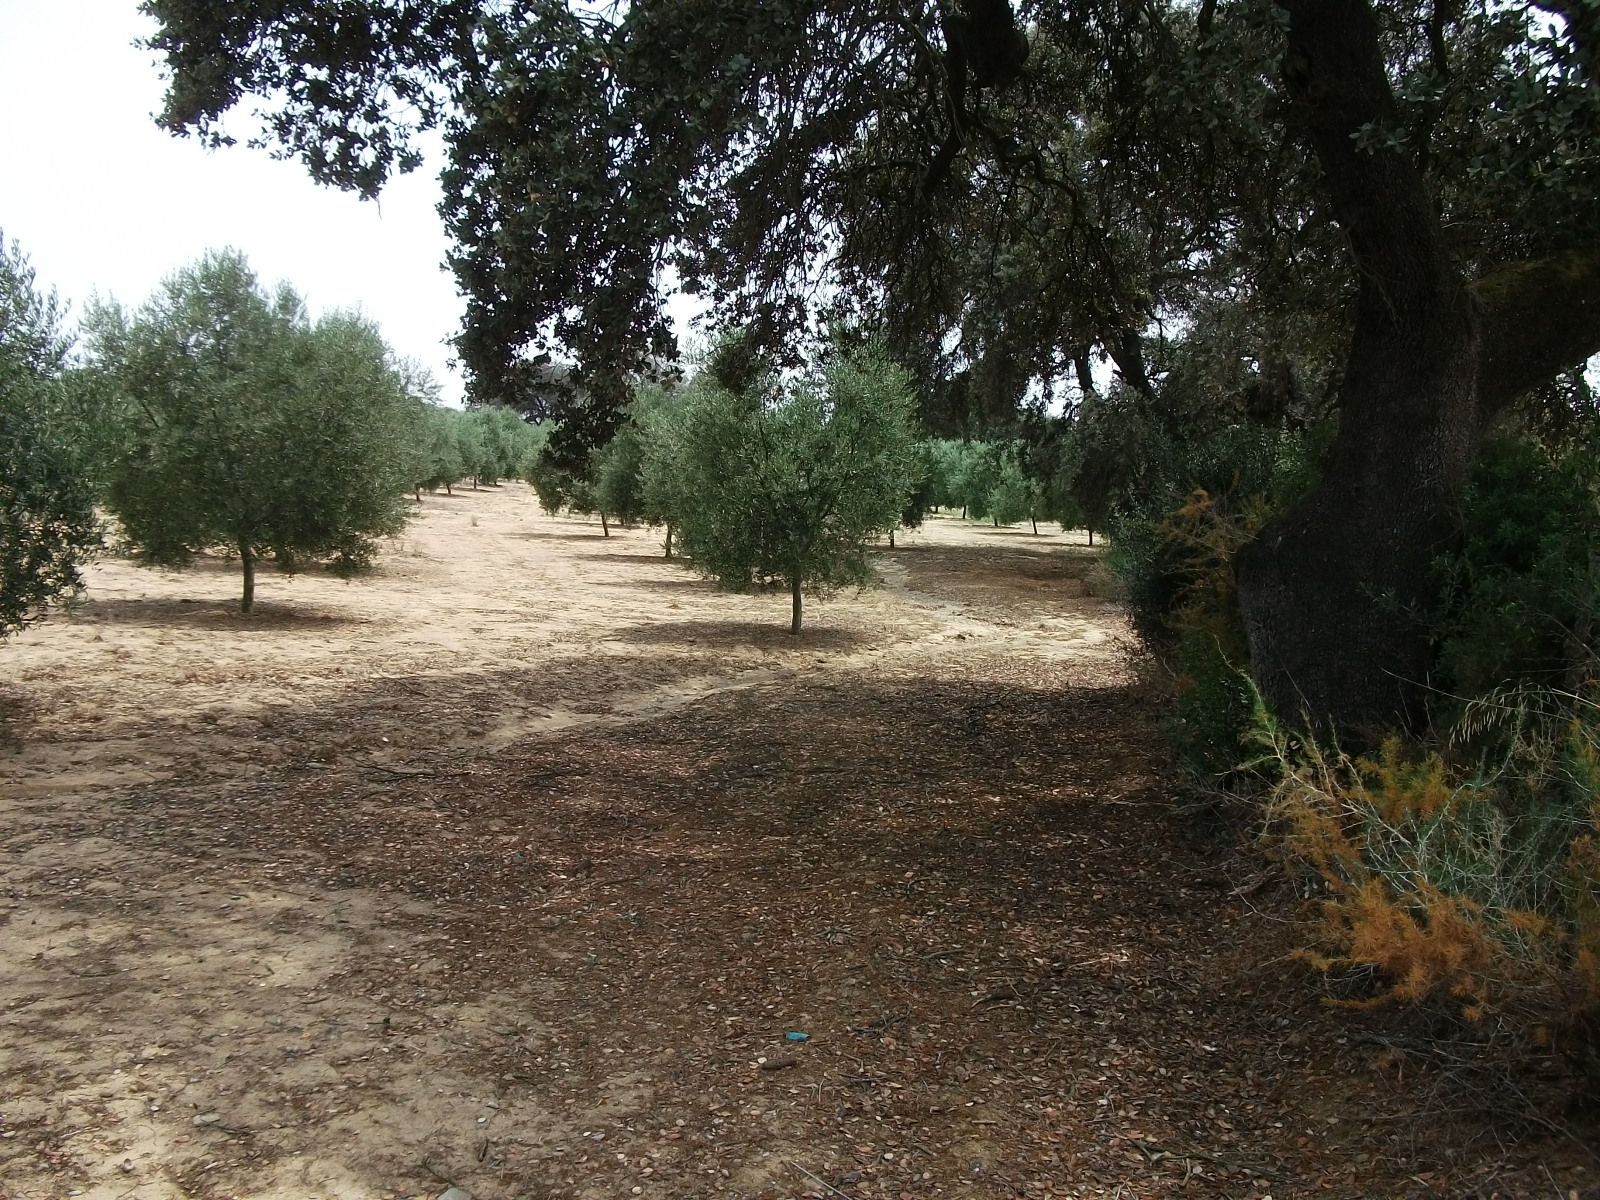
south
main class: Cropland
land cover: Durum wheat
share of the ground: > 75 %
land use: Agriculture (excluding fallow land and kitchen gardens)
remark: Harvested field
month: June
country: ES
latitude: 37.4080
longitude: -6.8849
